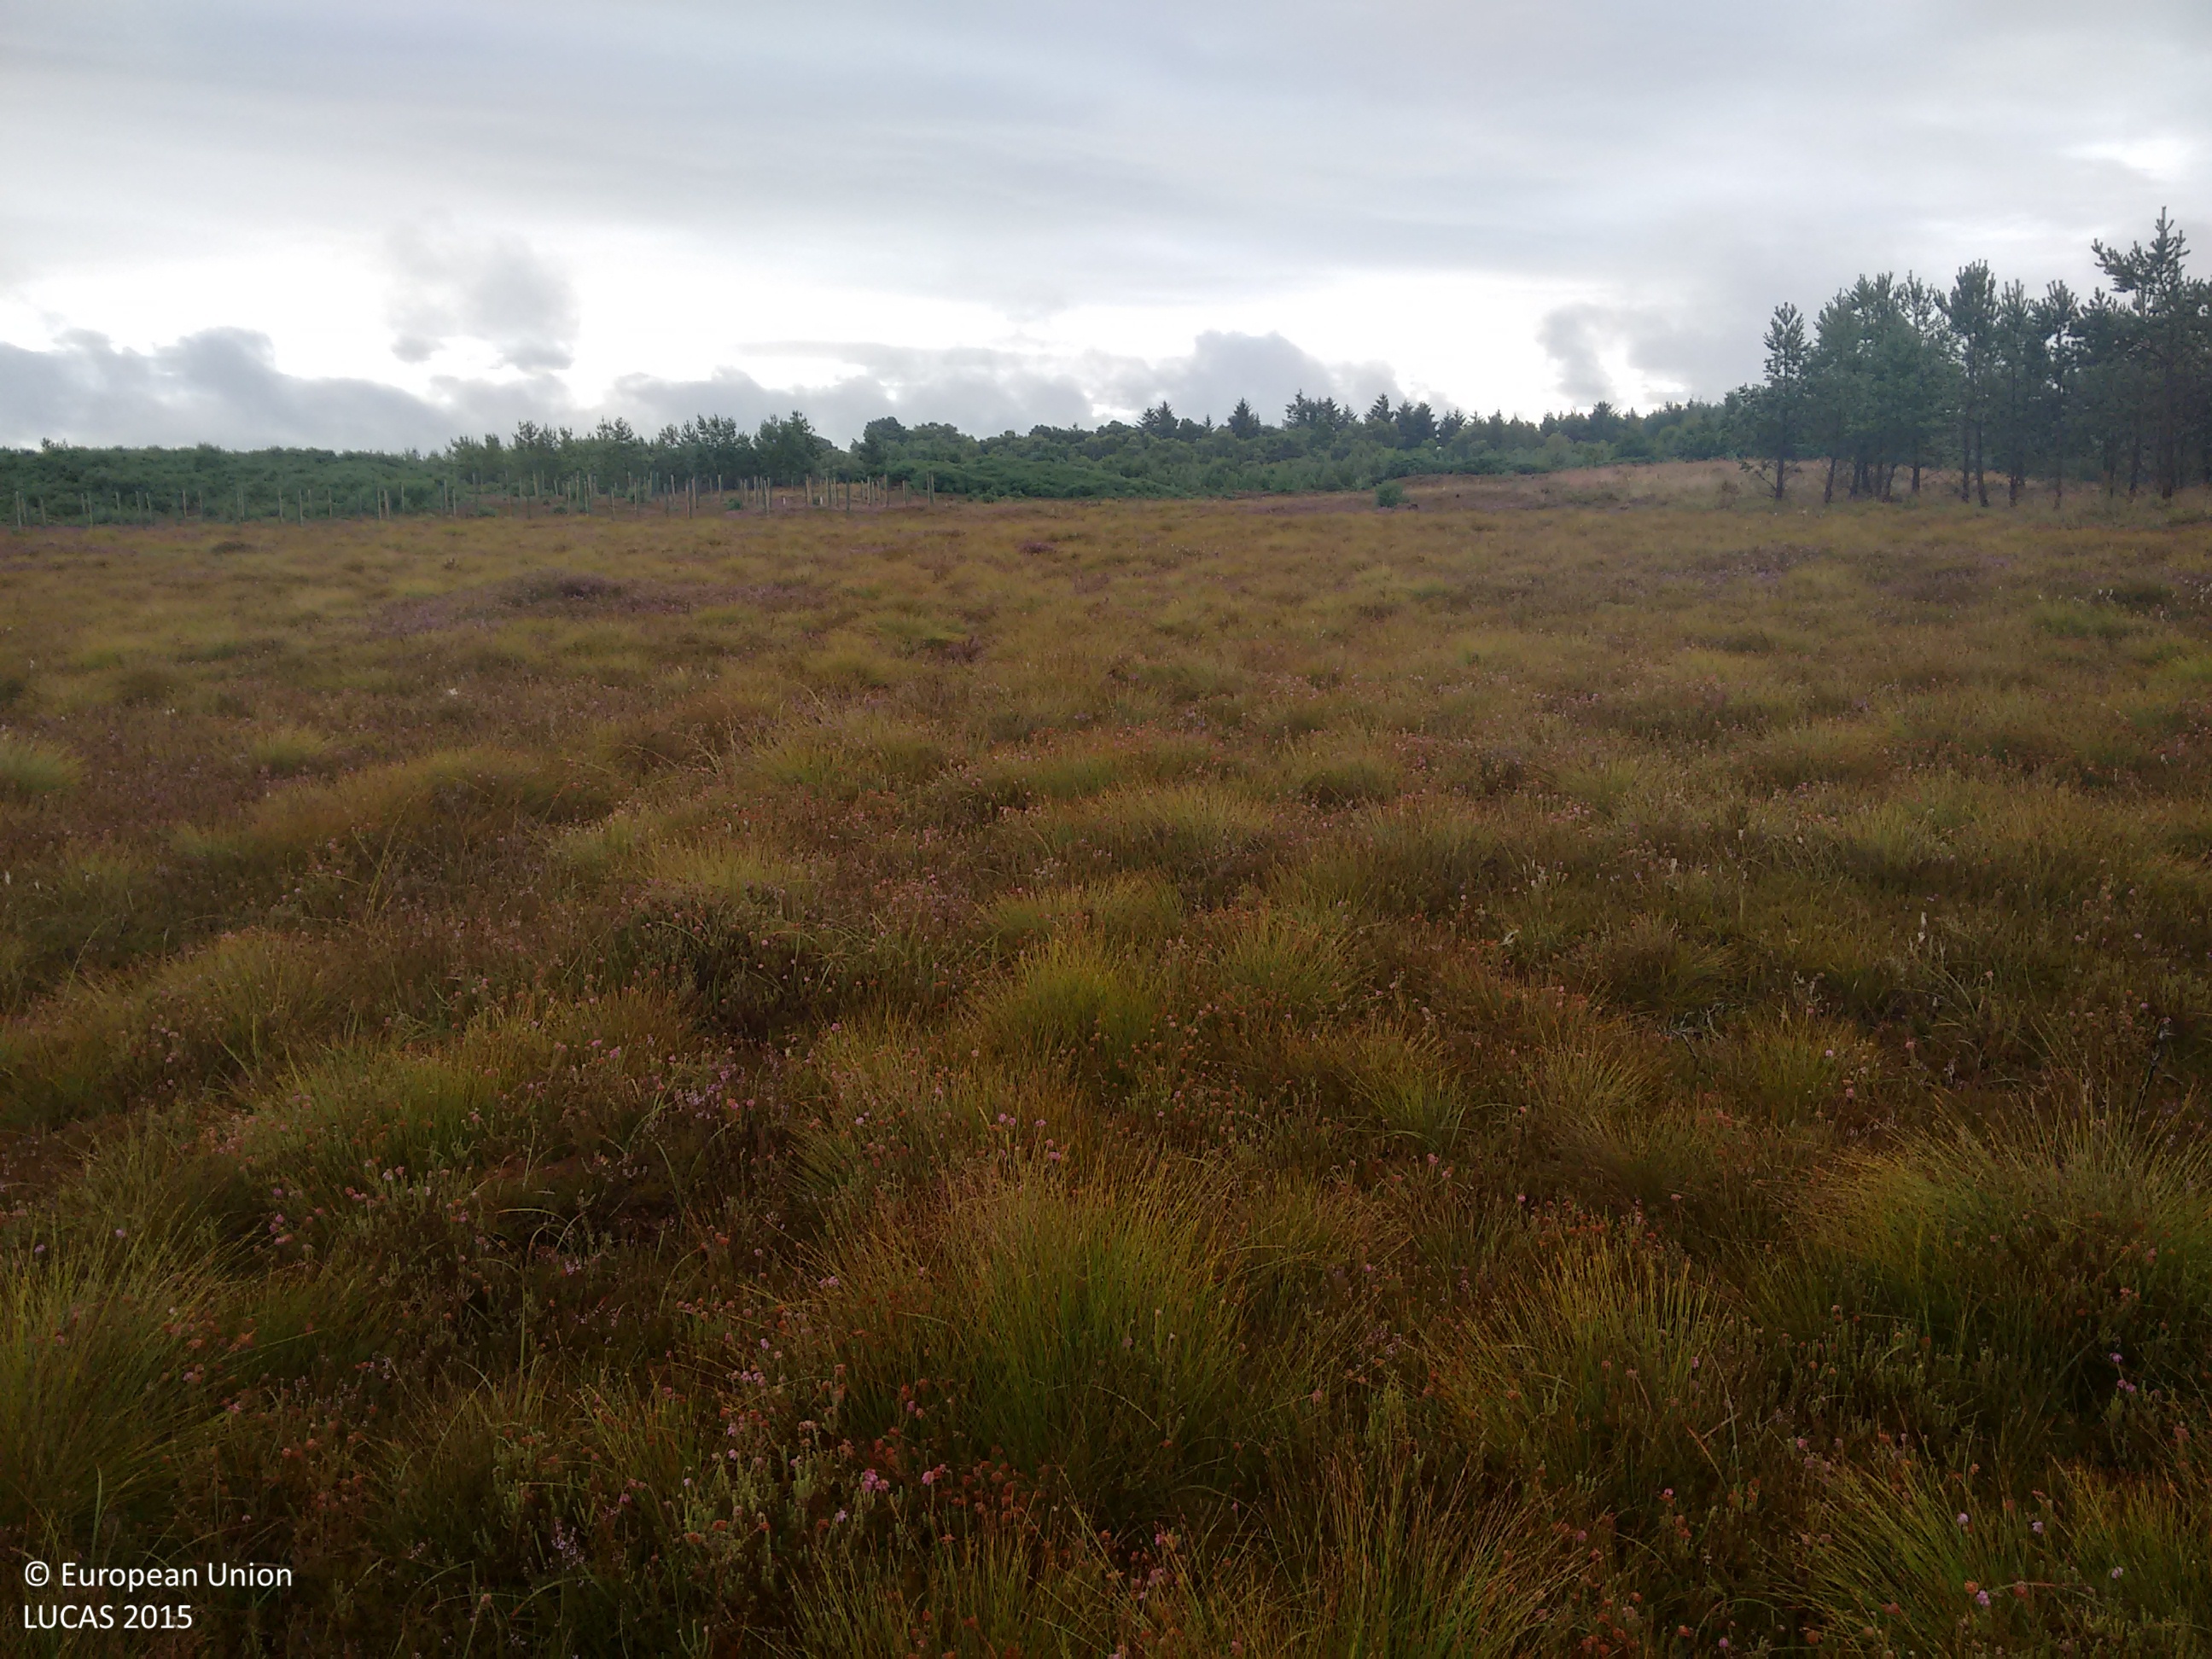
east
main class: Shrubland
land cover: Shrubland without tree cover
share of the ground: > 75 %
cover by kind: shrubs 55 %, herbaceous plants 40 %, lichens and mosses 5 %
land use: Semi-natural and natural areas not in use
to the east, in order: Shrubland without tree cover; Ditches and canals; Shrubland without tree cover; Shrubland with sparse tree cover; Pine dominated coniferous woodland; Shrubland without tree cover; Pine dominated coniferous woodland; Shrubland with sparse tree cover; Broadleaved woodland
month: August
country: GB
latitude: 57.7937
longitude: -3.9908
